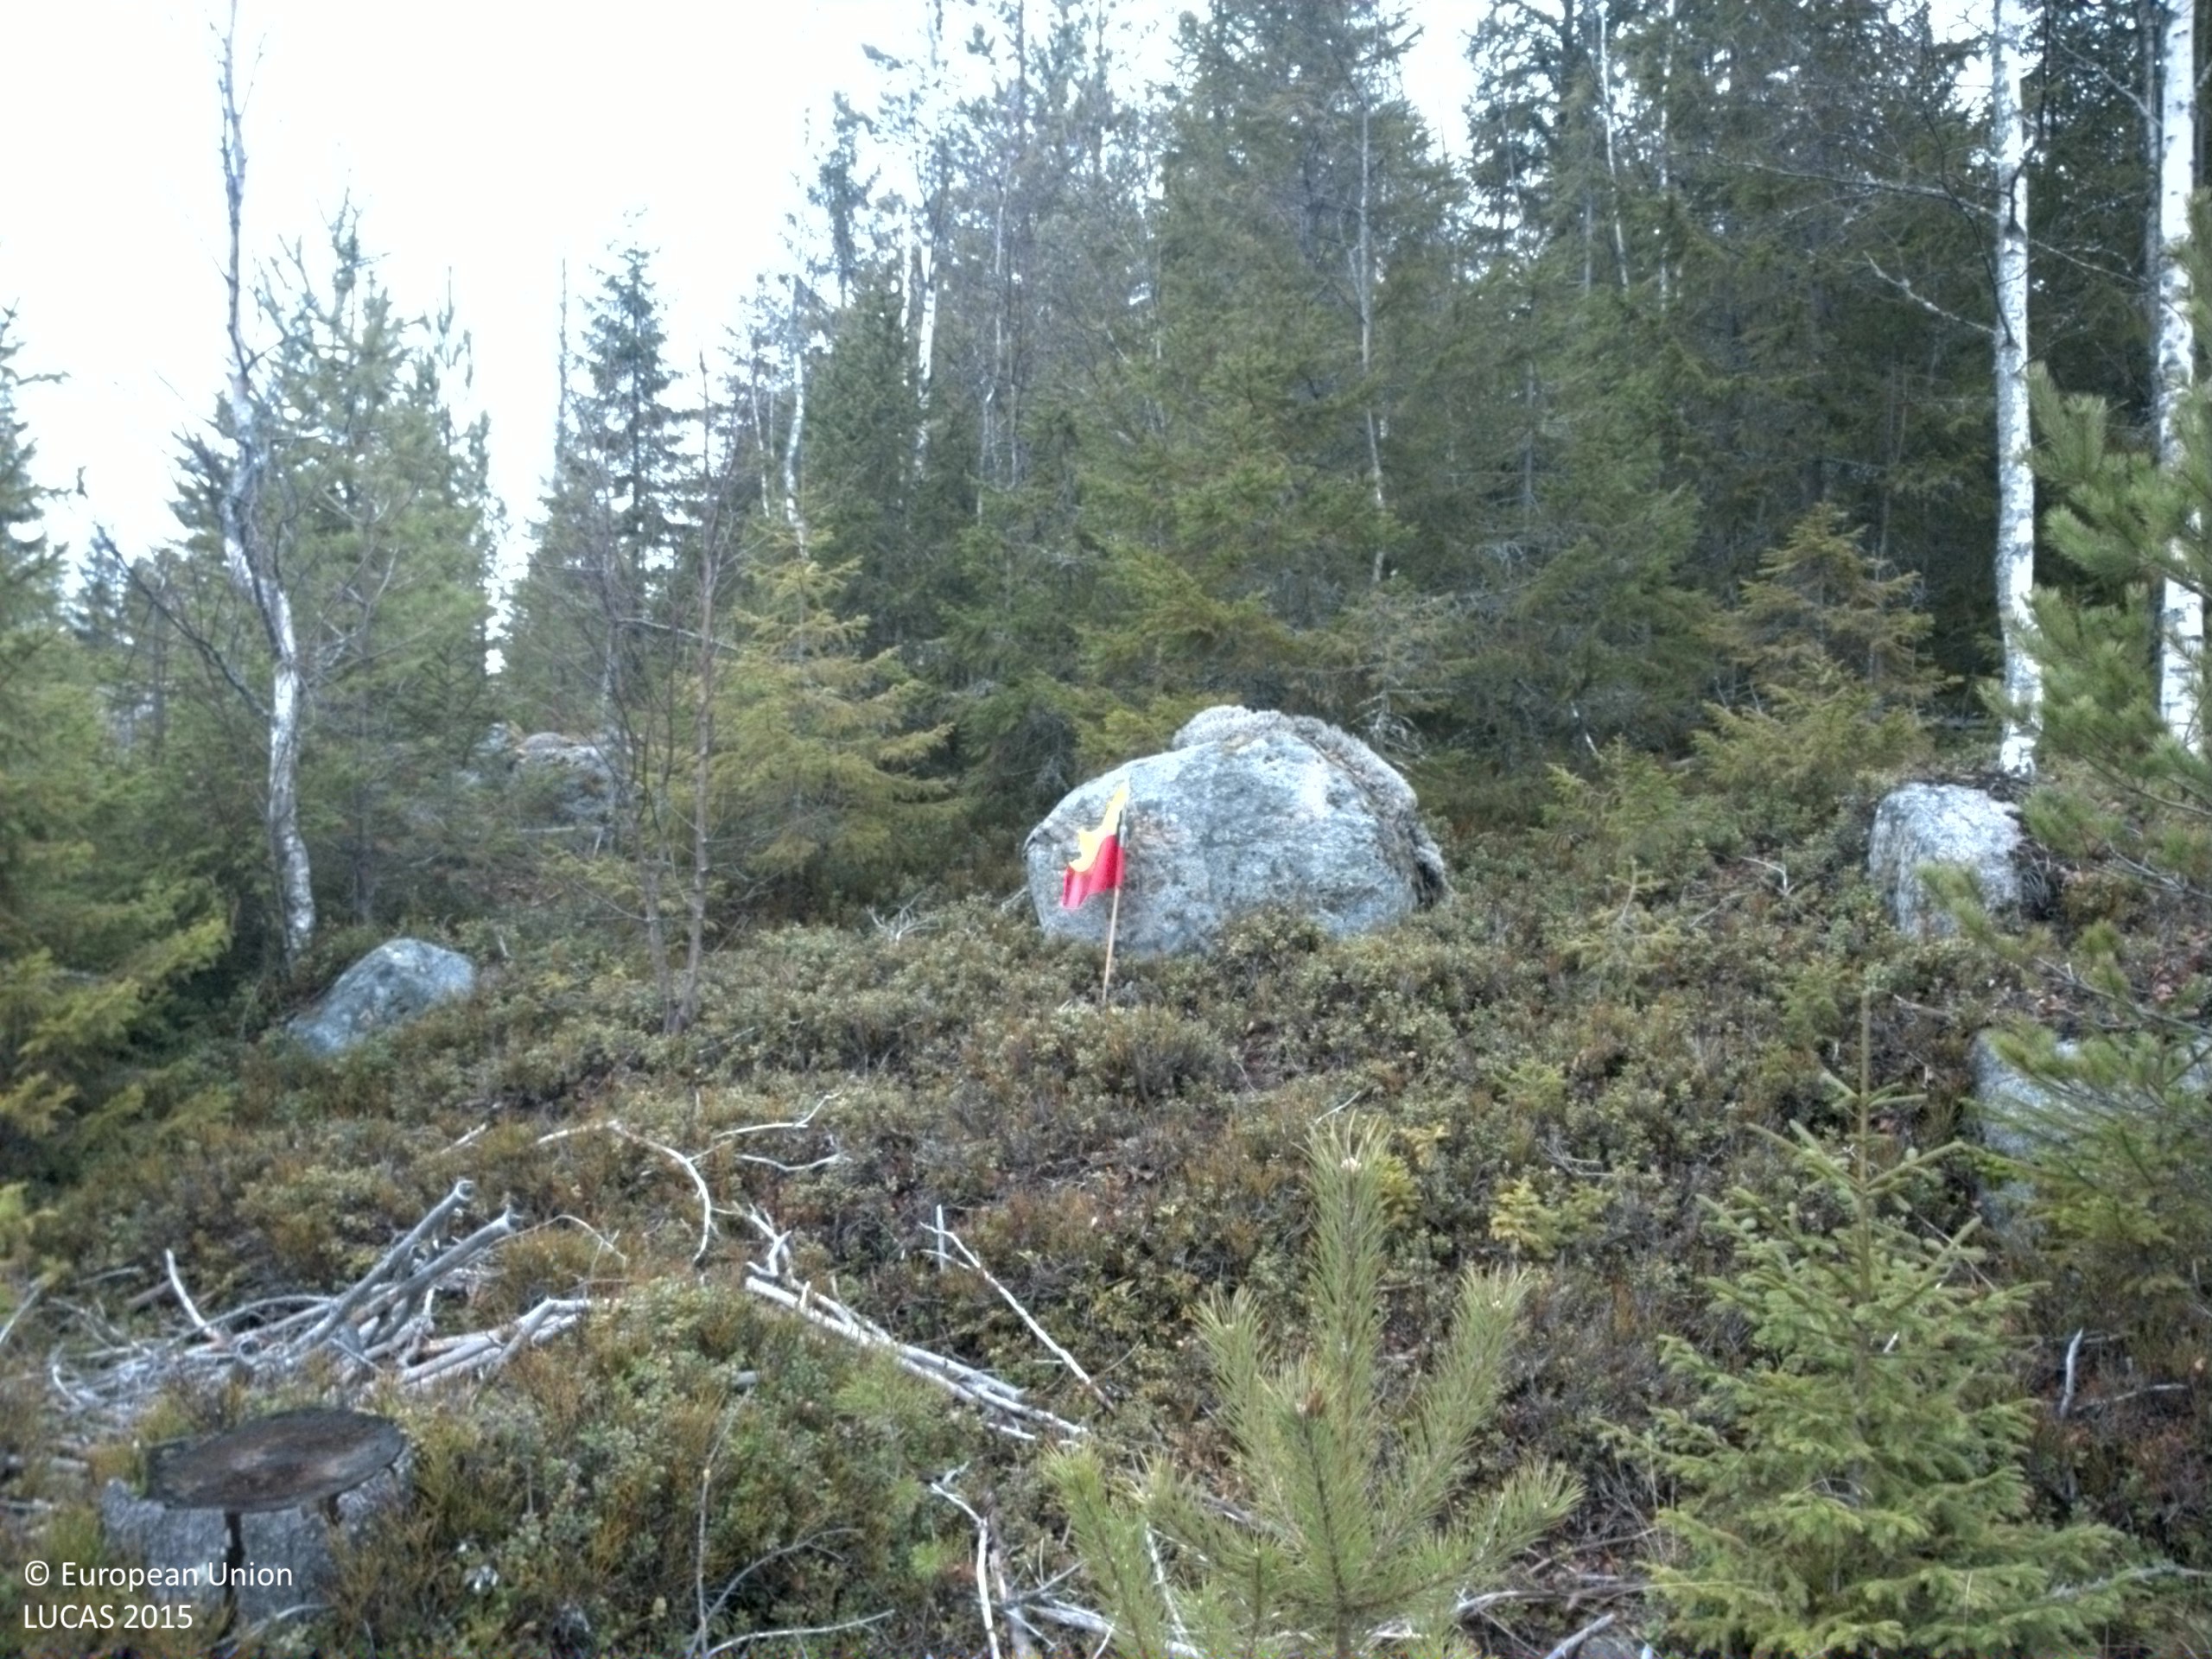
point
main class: Woodland
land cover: Other mixed woodland
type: boreal forest
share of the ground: 25 - 50 %
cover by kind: shrubs 35 %, coniferous forest trees 25 %, lichens and mosses 20 %, broadleaved forest trees 10 %, herbaceous plants 5 %, consolidated bare surface 5 %
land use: Forestry
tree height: < 5 m
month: November
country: SE
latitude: 61.5819
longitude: 16.9725
